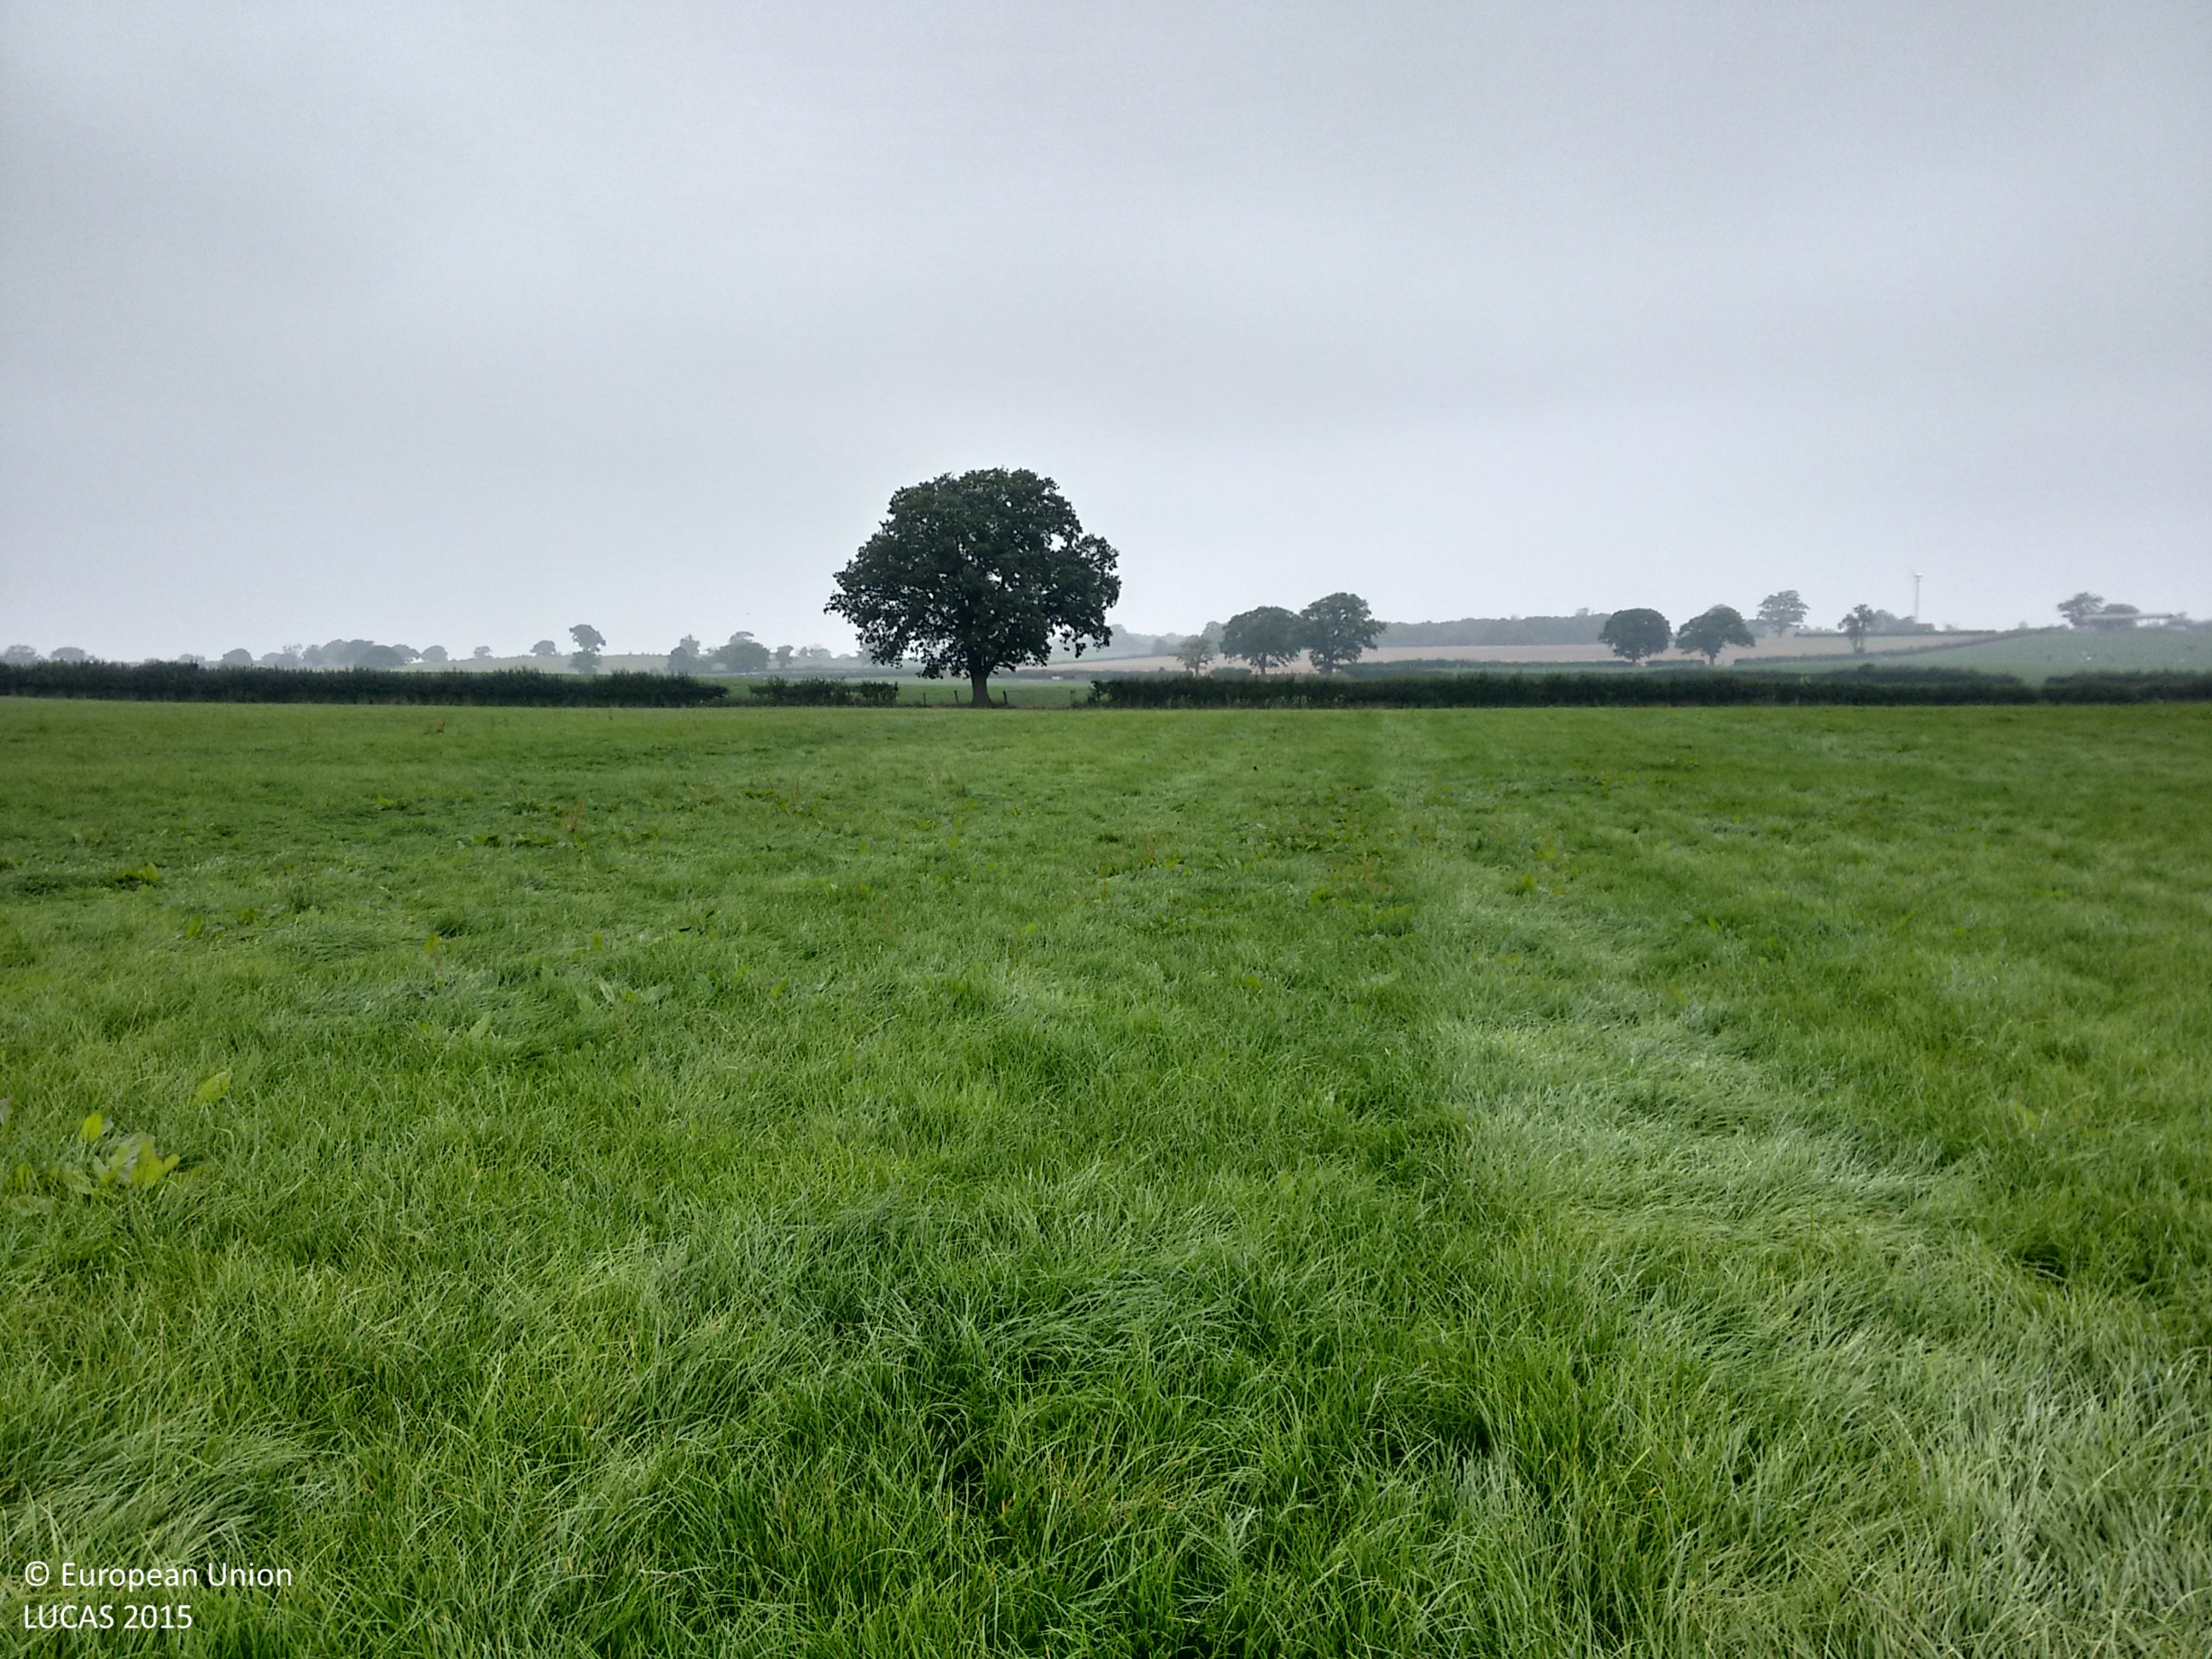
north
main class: Grassland
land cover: Grassland without tree/shrub cover
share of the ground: > 75 %
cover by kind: herbaceous plants 100 %
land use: Agriculture (excluding fallow land and kitchen gardens)
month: September
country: GB
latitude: 52.7013
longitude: -2.9637
